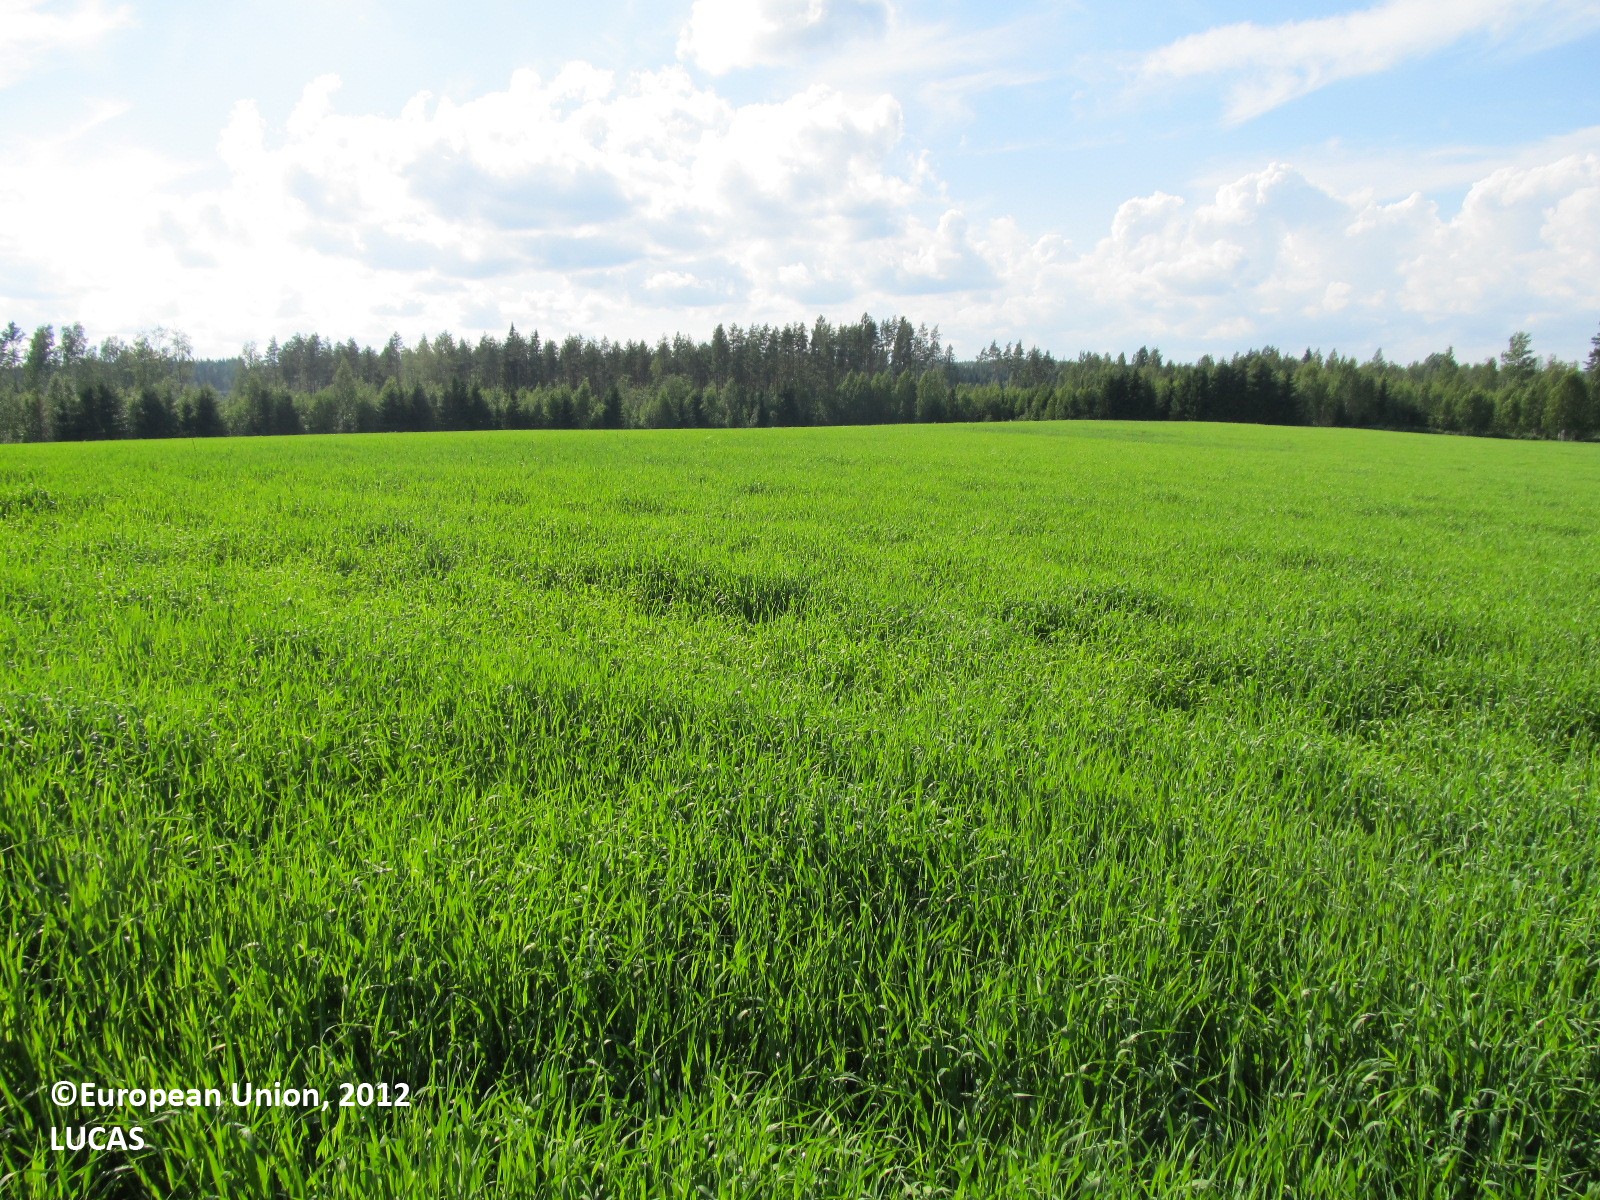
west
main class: Cropland
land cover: Barley
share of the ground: 50 - 75 %
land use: Agriculture (excluding fallow land and kitchen gardens)
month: July
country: FI
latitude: 61.9576
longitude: 28.4528
